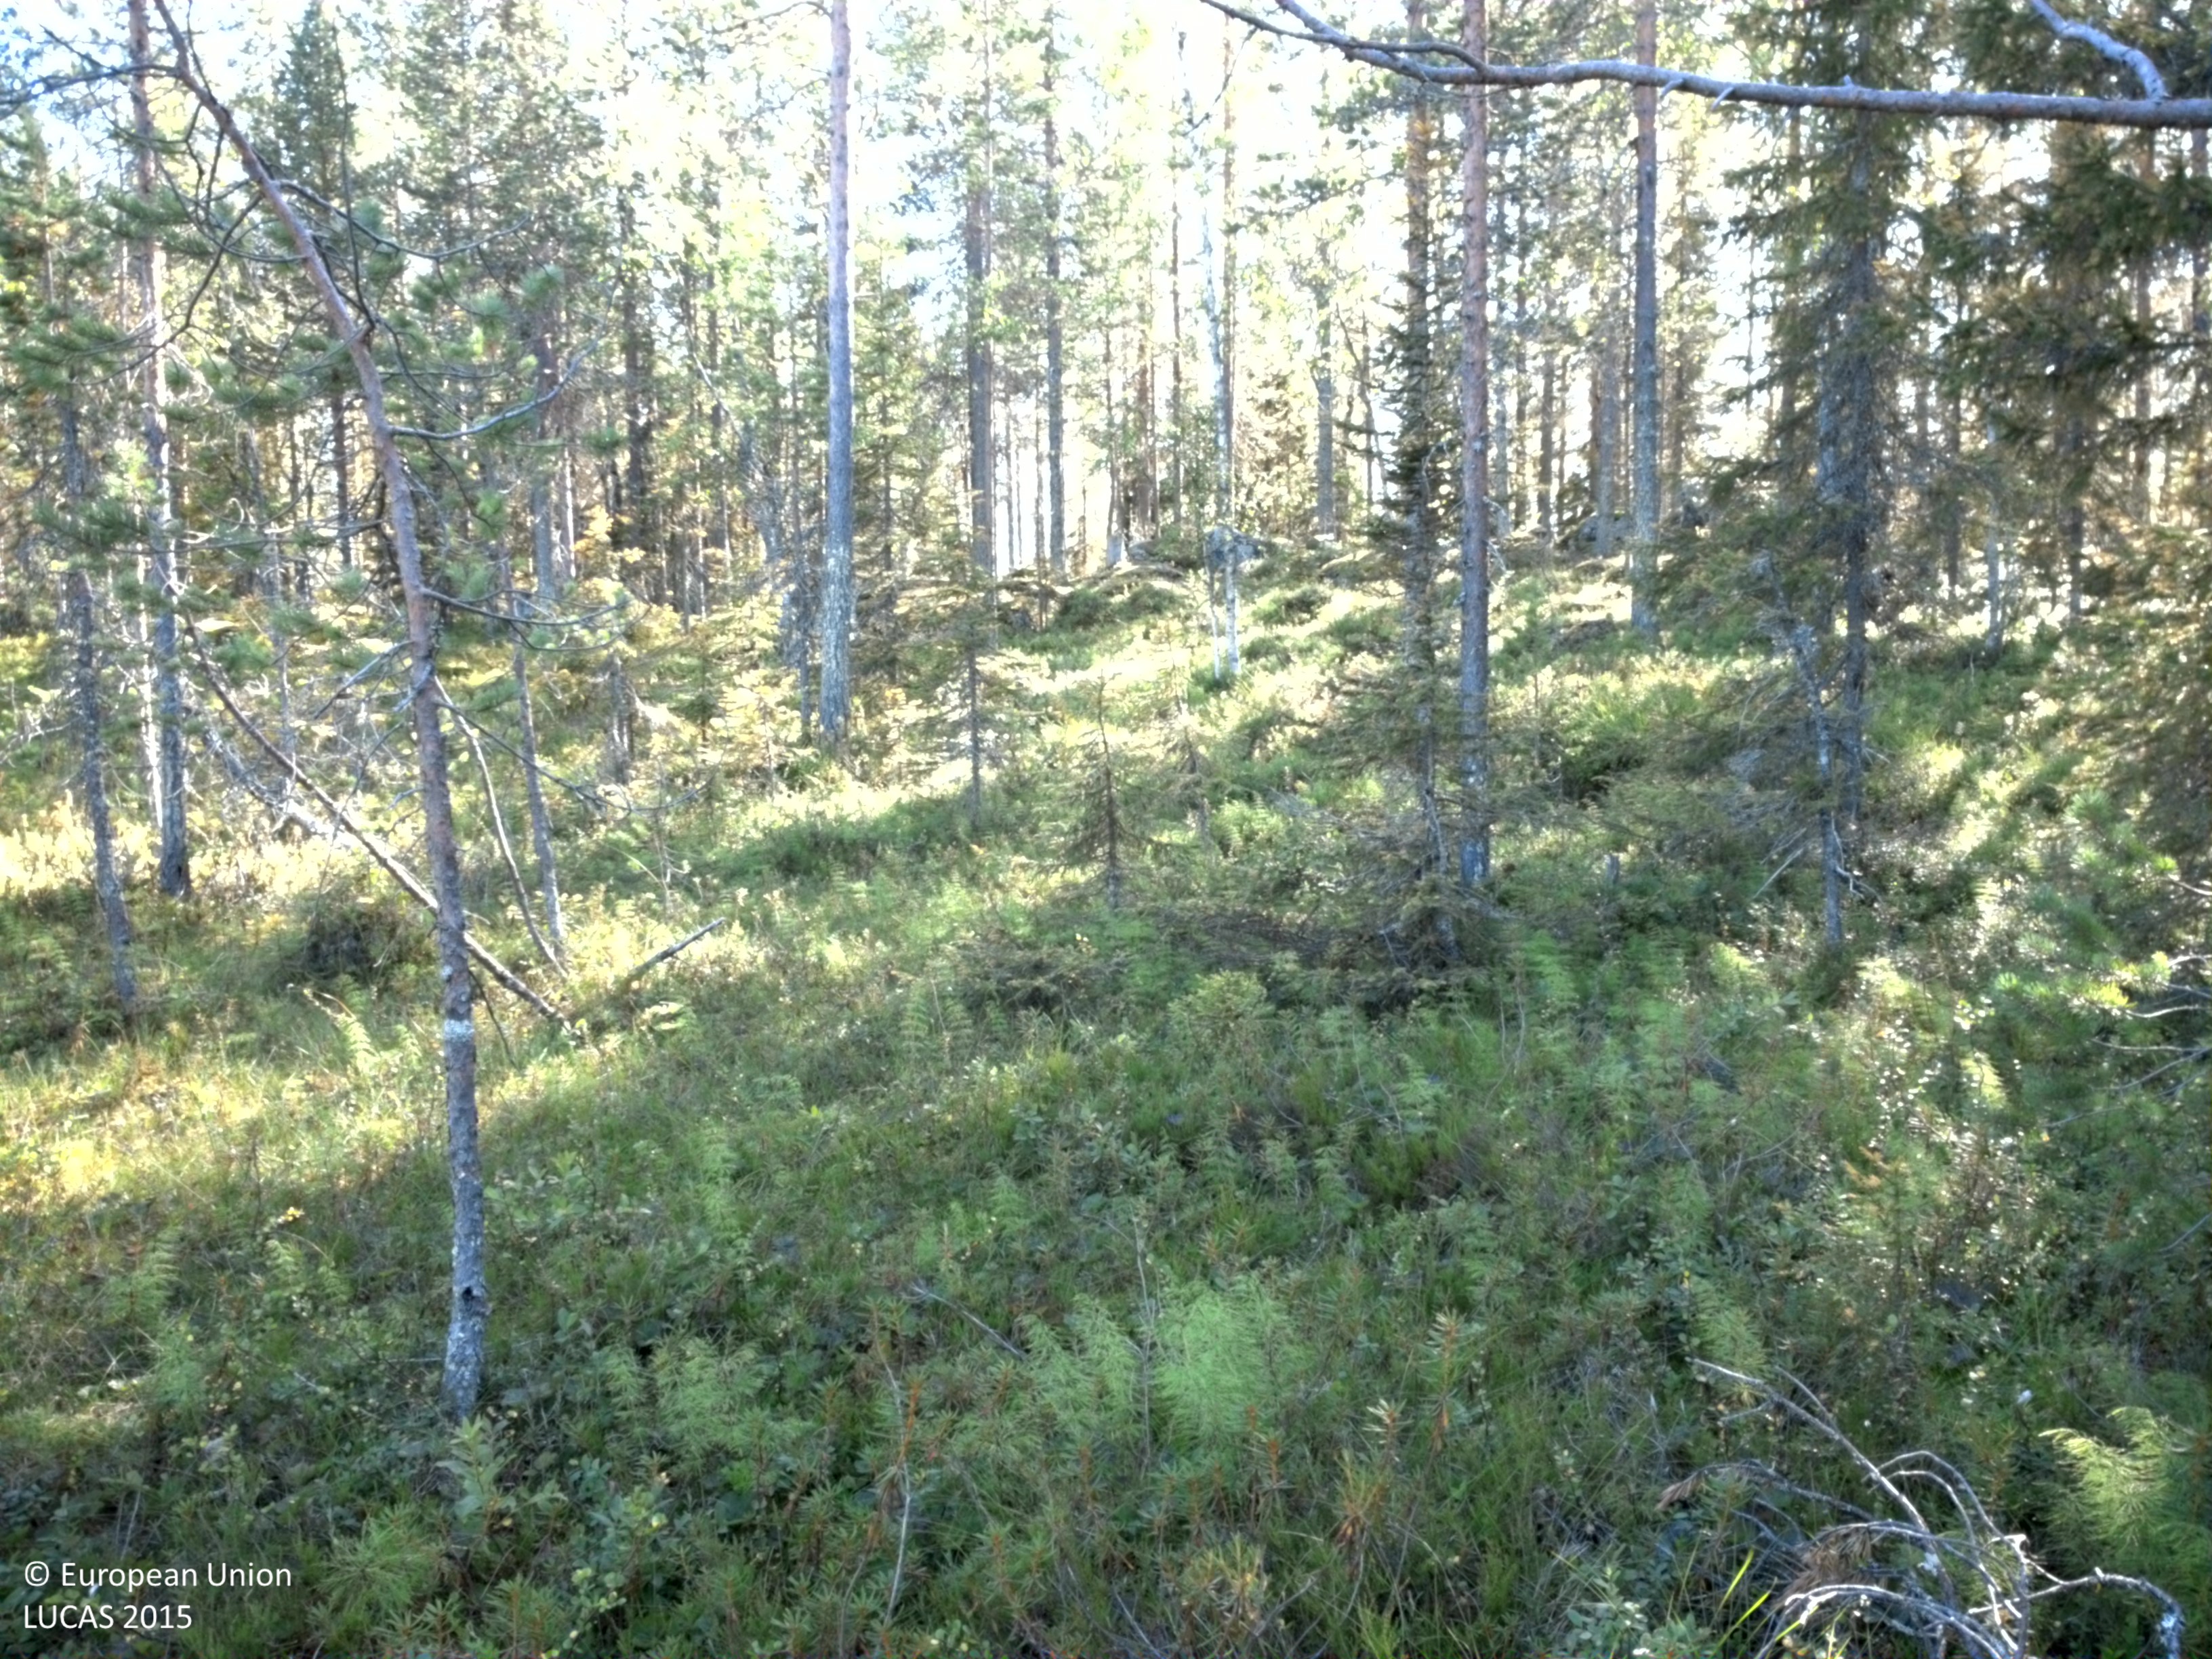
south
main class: Woodland
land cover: Pine dominated coniferous woodland
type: boreal forest
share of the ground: 25 - 50 %
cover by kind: shrubs 65 %, coniferous forest trees 30 %, lichens and mosses 5 %
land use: Forestry
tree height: > 5 m
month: August
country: SE
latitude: 66.1136
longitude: 22.6153
